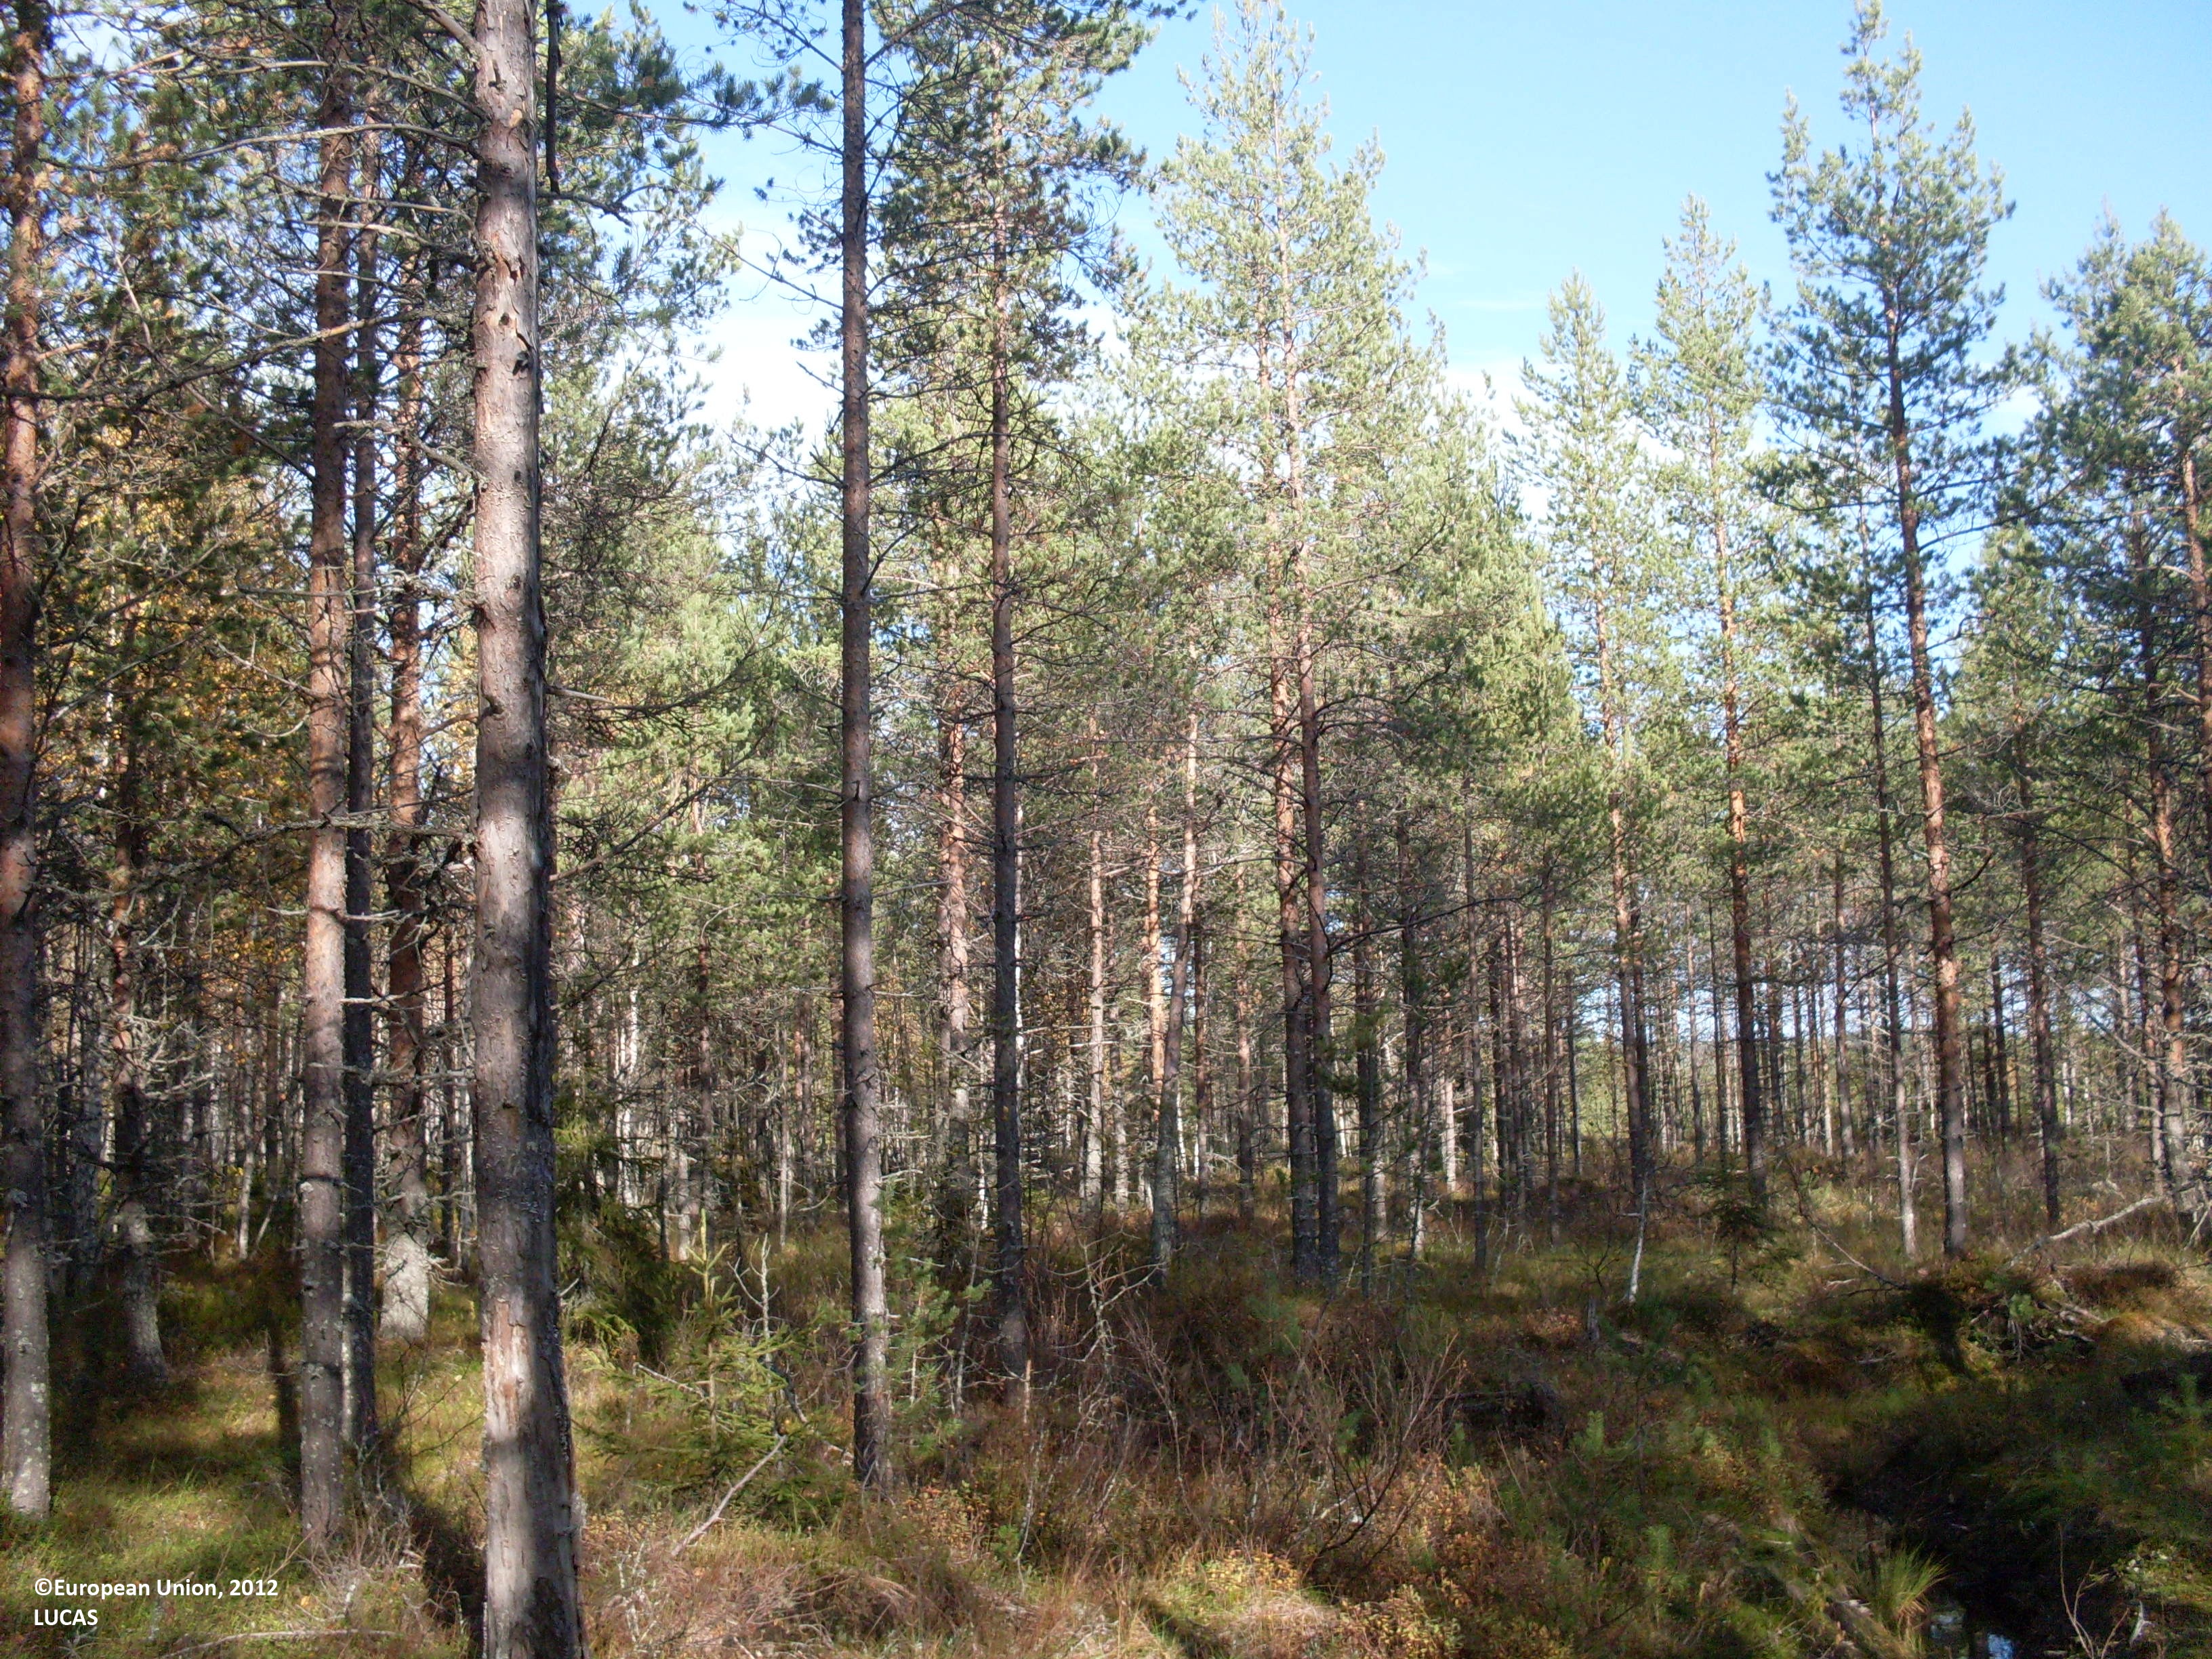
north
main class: Woodland
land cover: Pine dominated coniferous woodland
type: boreal forest
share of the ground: 50 - 75 %
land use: Forestry
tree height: > 5 m
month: September
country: FI
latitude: 64.3292
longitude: 28.7457
